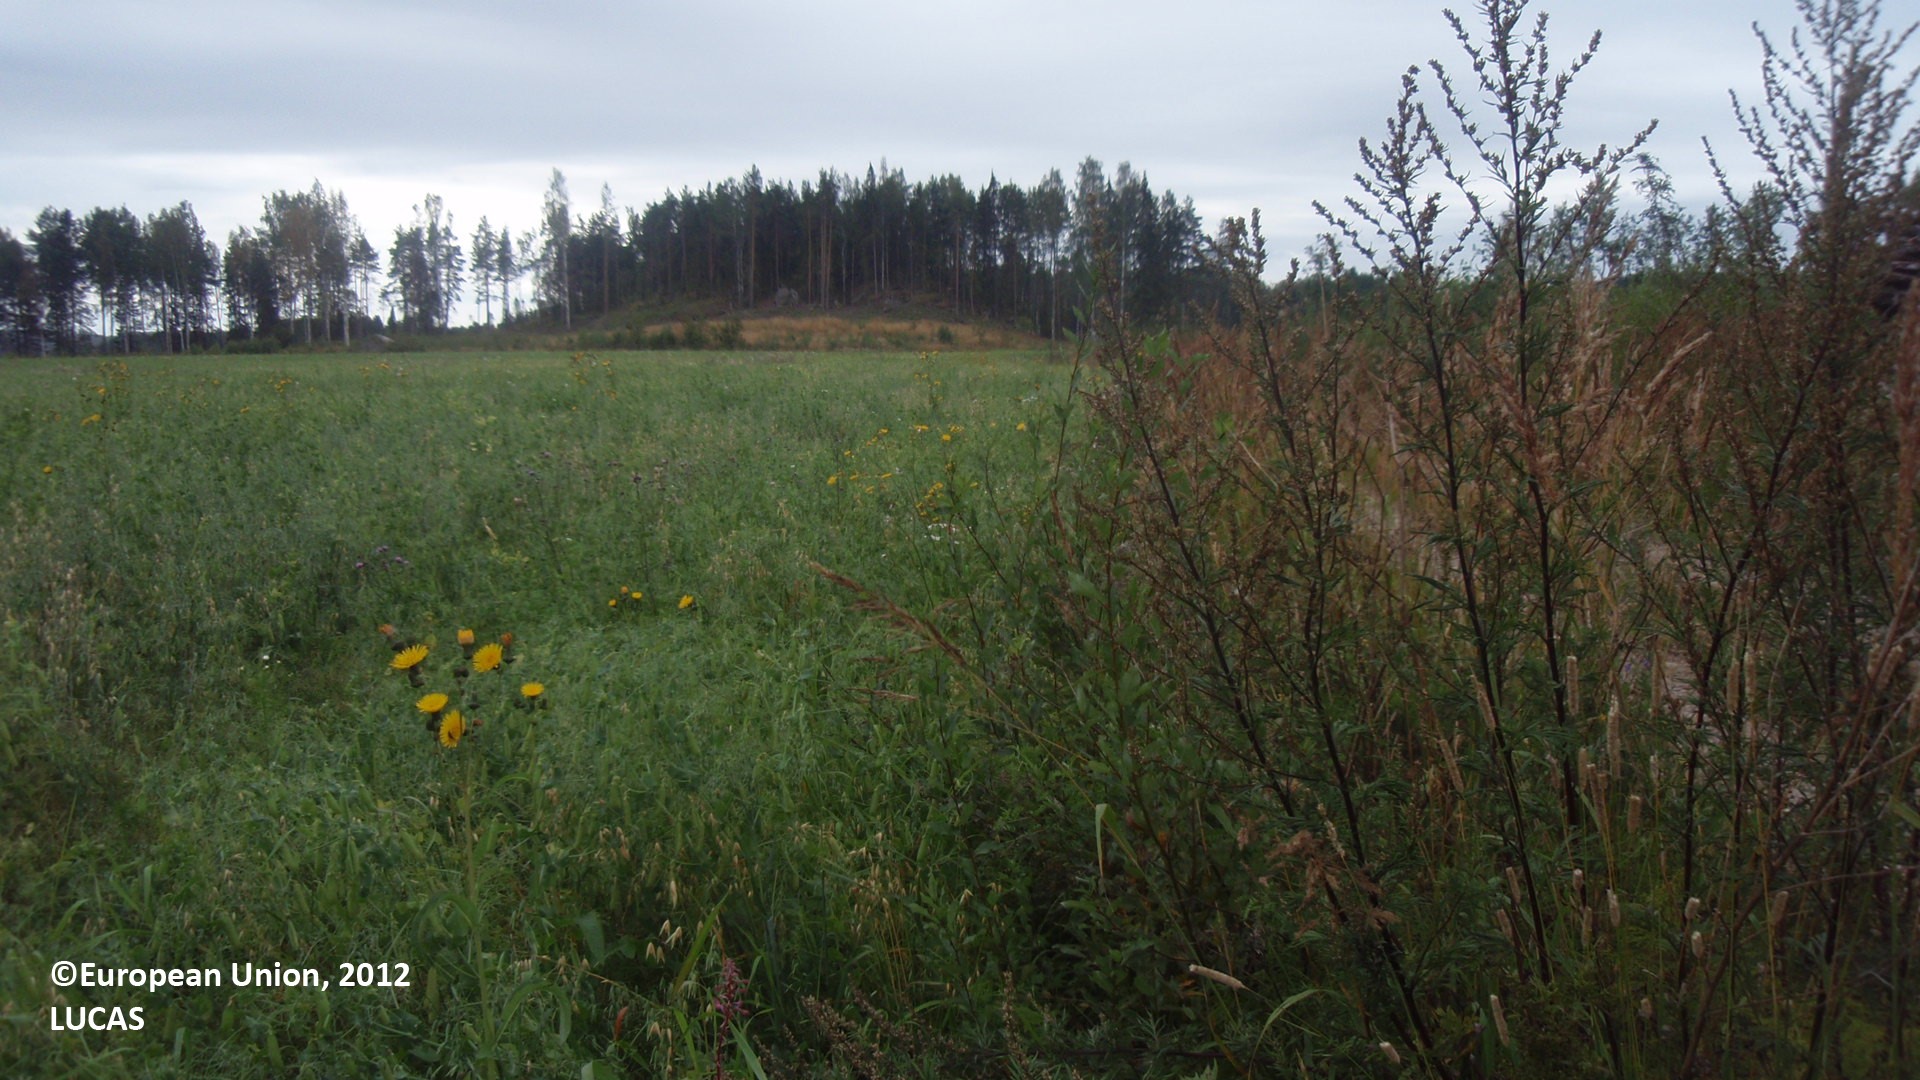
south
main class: Cropland
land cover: Dry pulses
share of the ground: > 75 %
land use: Agriculture (excluding fallow land and kitchen gardens)
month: August
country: FI
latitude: 61.0194
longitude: 26.7174
